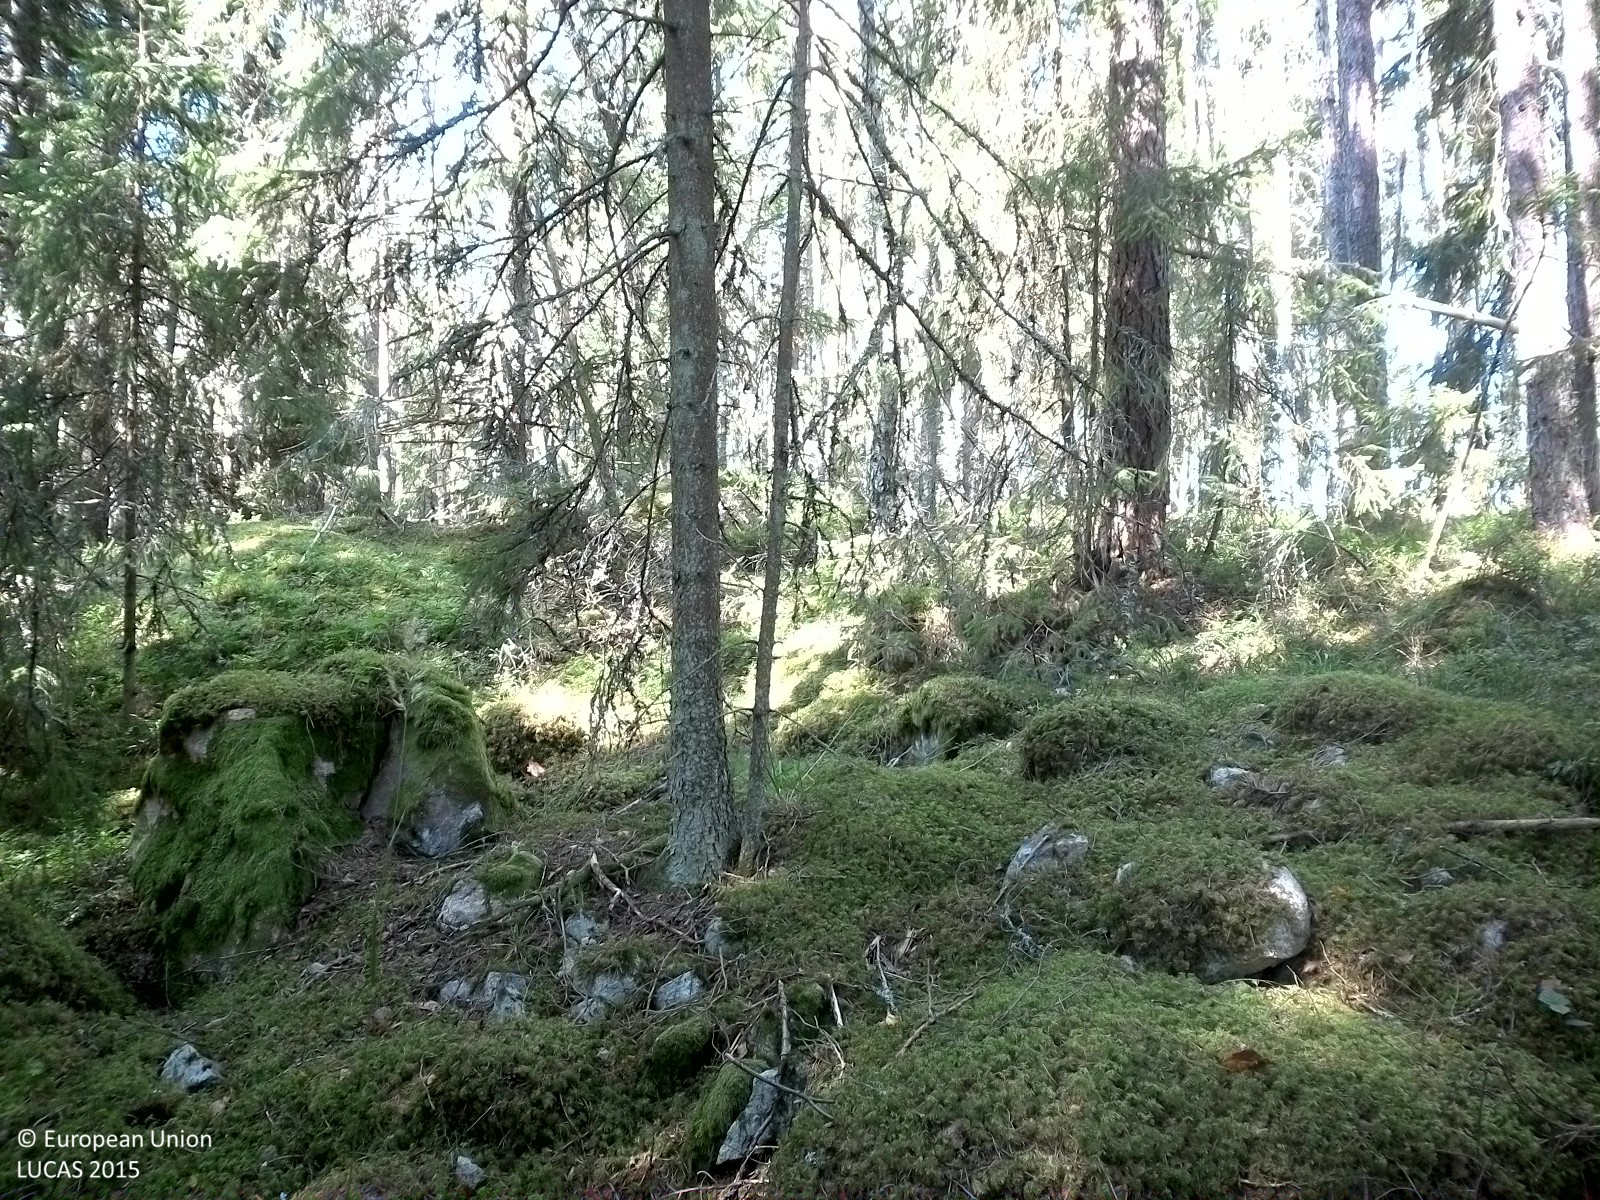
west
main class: Woodland
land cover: Other coniferous woodland
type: boreal forest
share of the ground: 25 - 50 %
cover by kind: coniferous forest trees 45 %, lichens and mosses 40 %, herbaceous plants 15 %
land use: Forestry
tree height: > 5 m
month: August
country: SE
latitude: 58.7579
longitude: 14.9887
